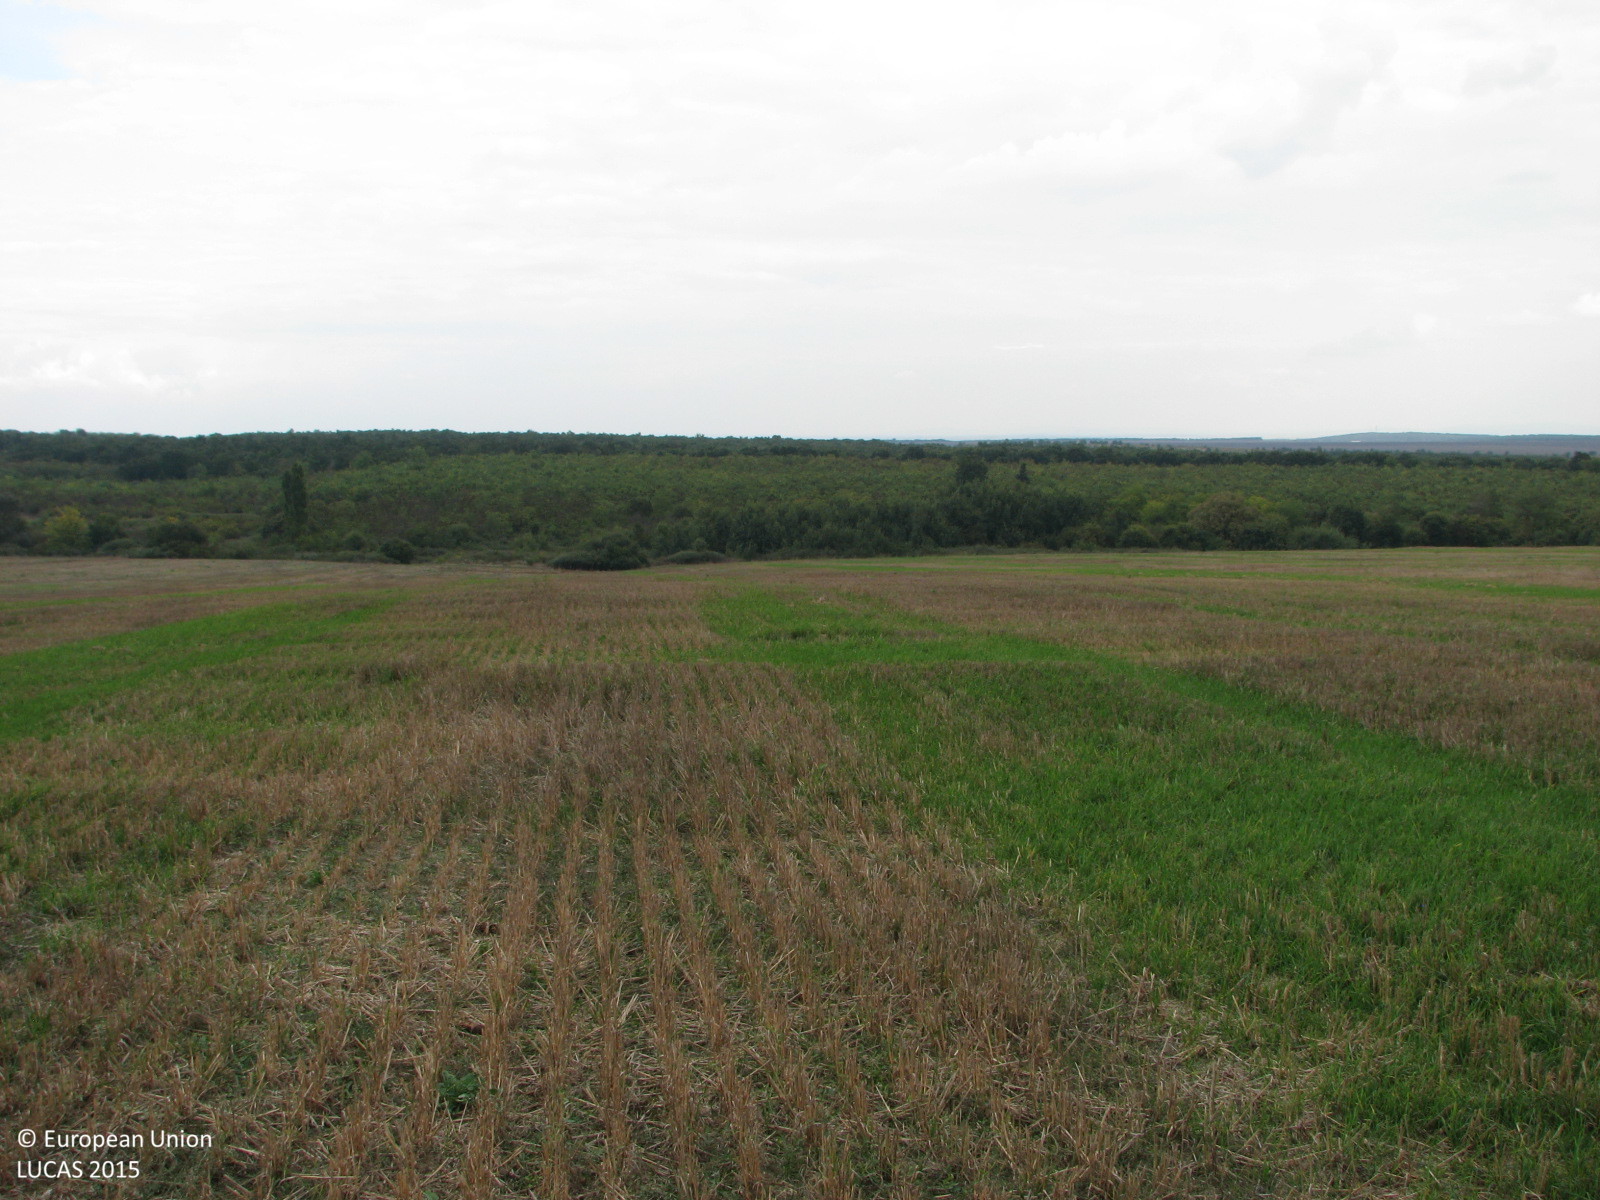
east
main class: Cropland
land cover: Common wheat
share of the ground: > 75 %
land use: Agriculture (excluding fallow land and kitchen gardens)
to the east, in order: Common wheat
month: October
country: BG
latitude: 42.2739
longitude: 26.4446
